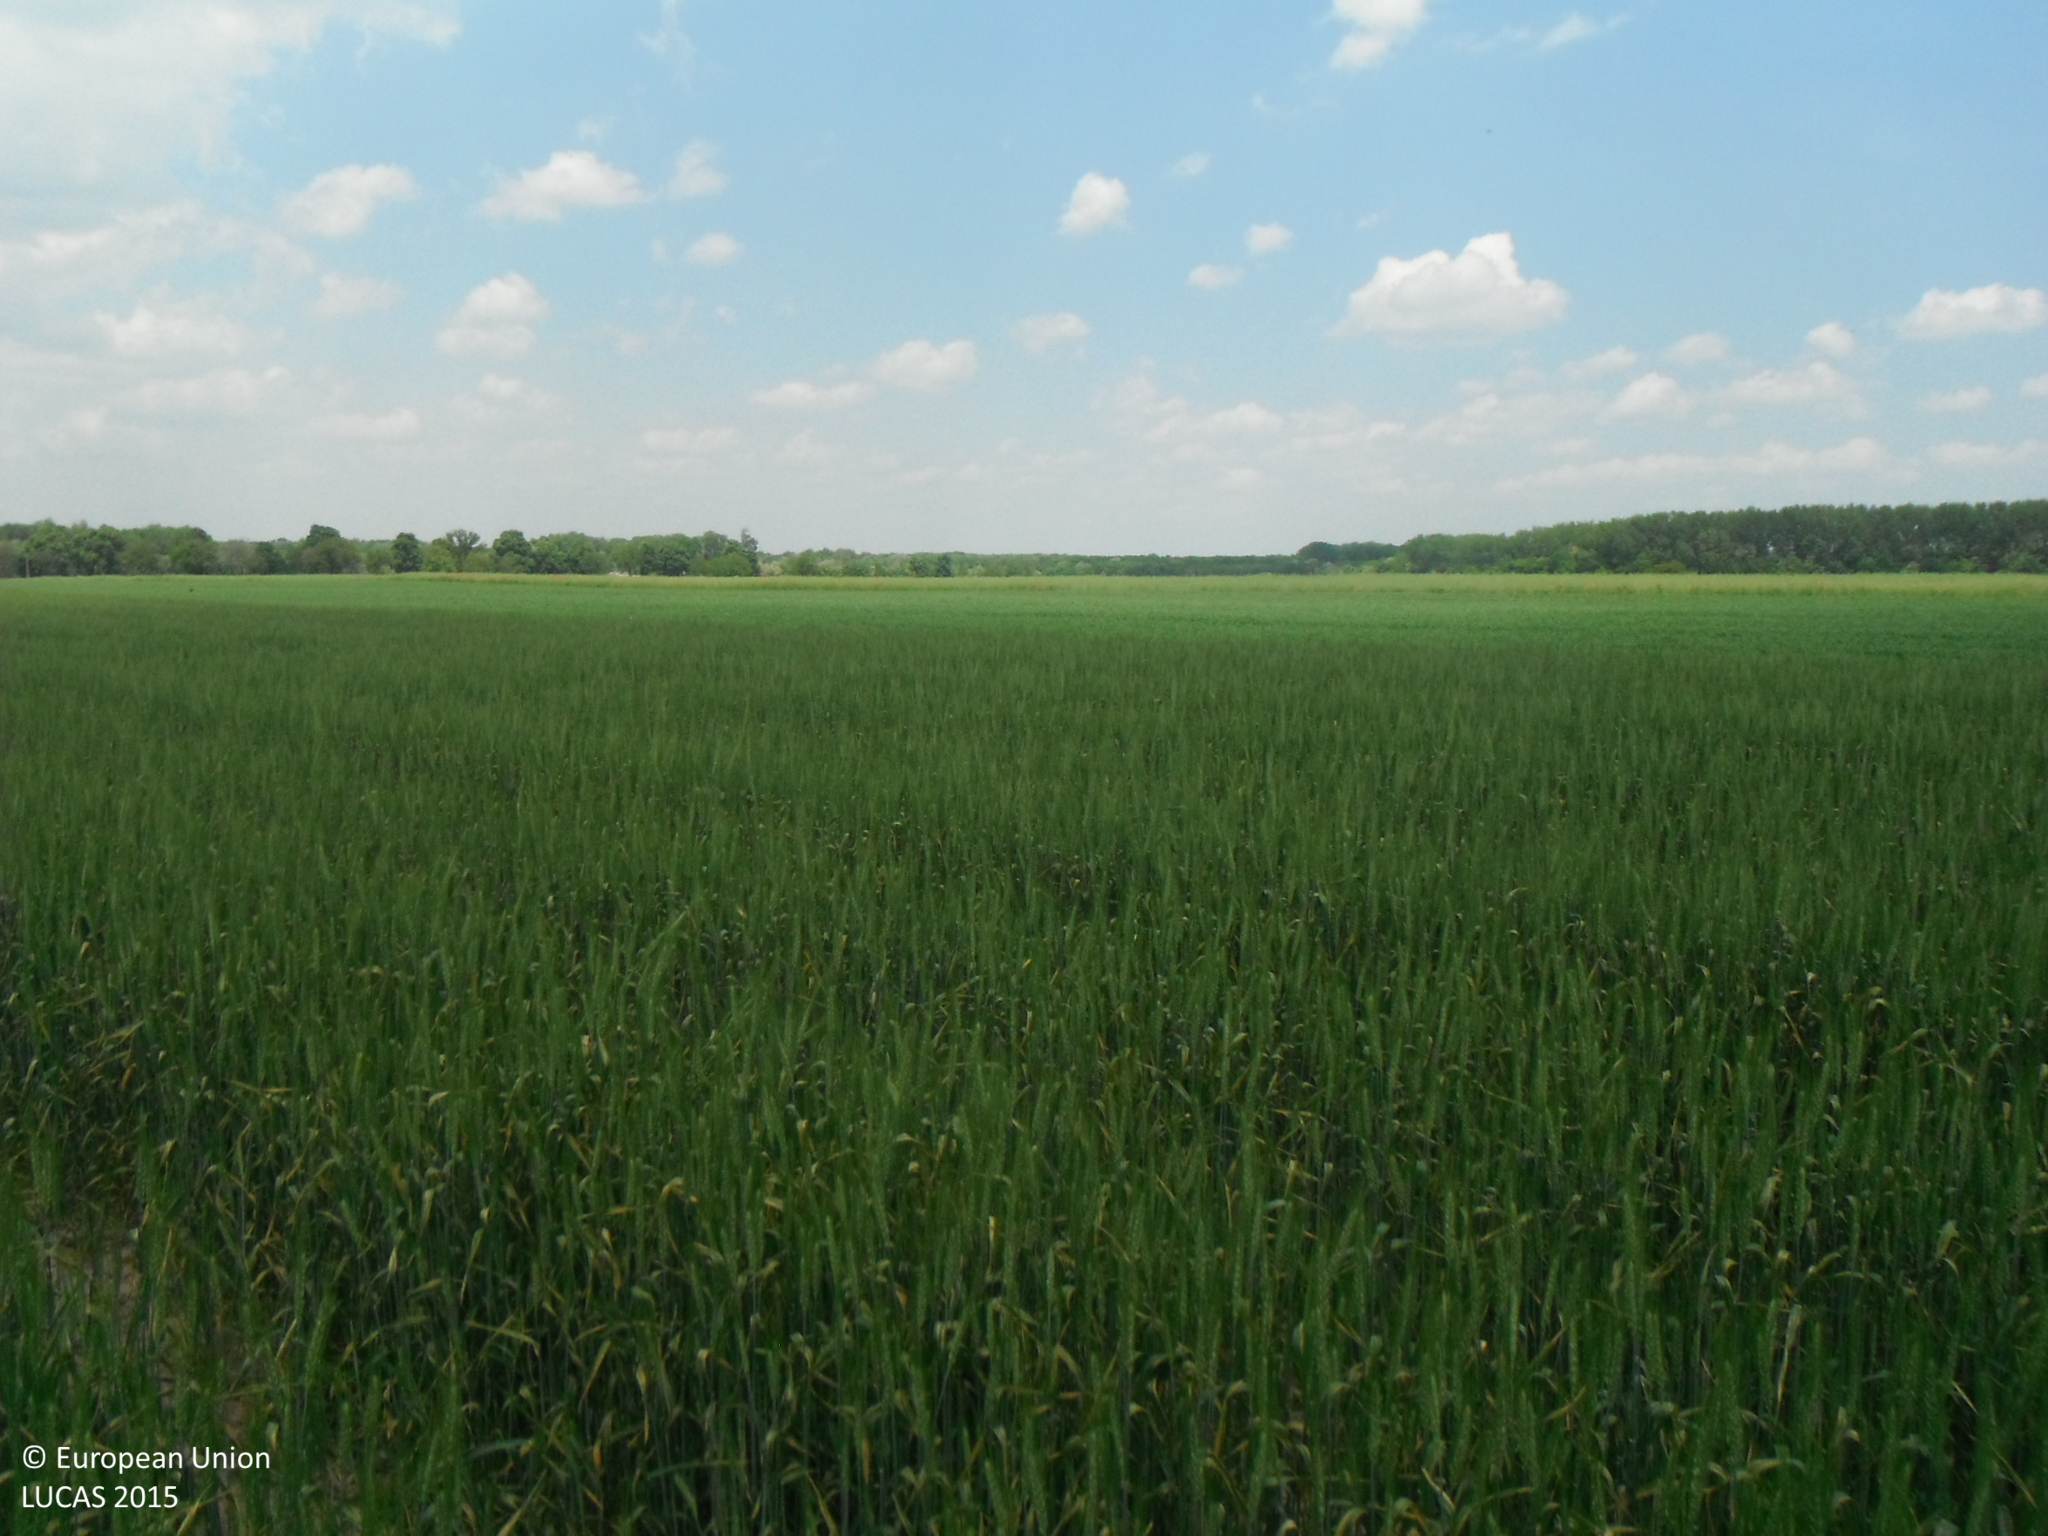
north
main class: Cropland
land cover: Common wheat
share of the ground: > 75 %
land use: Agriculture (excluding fallow land and kitchen gardens)
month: May
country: SK
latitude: 48.0230
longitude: 17.7476
